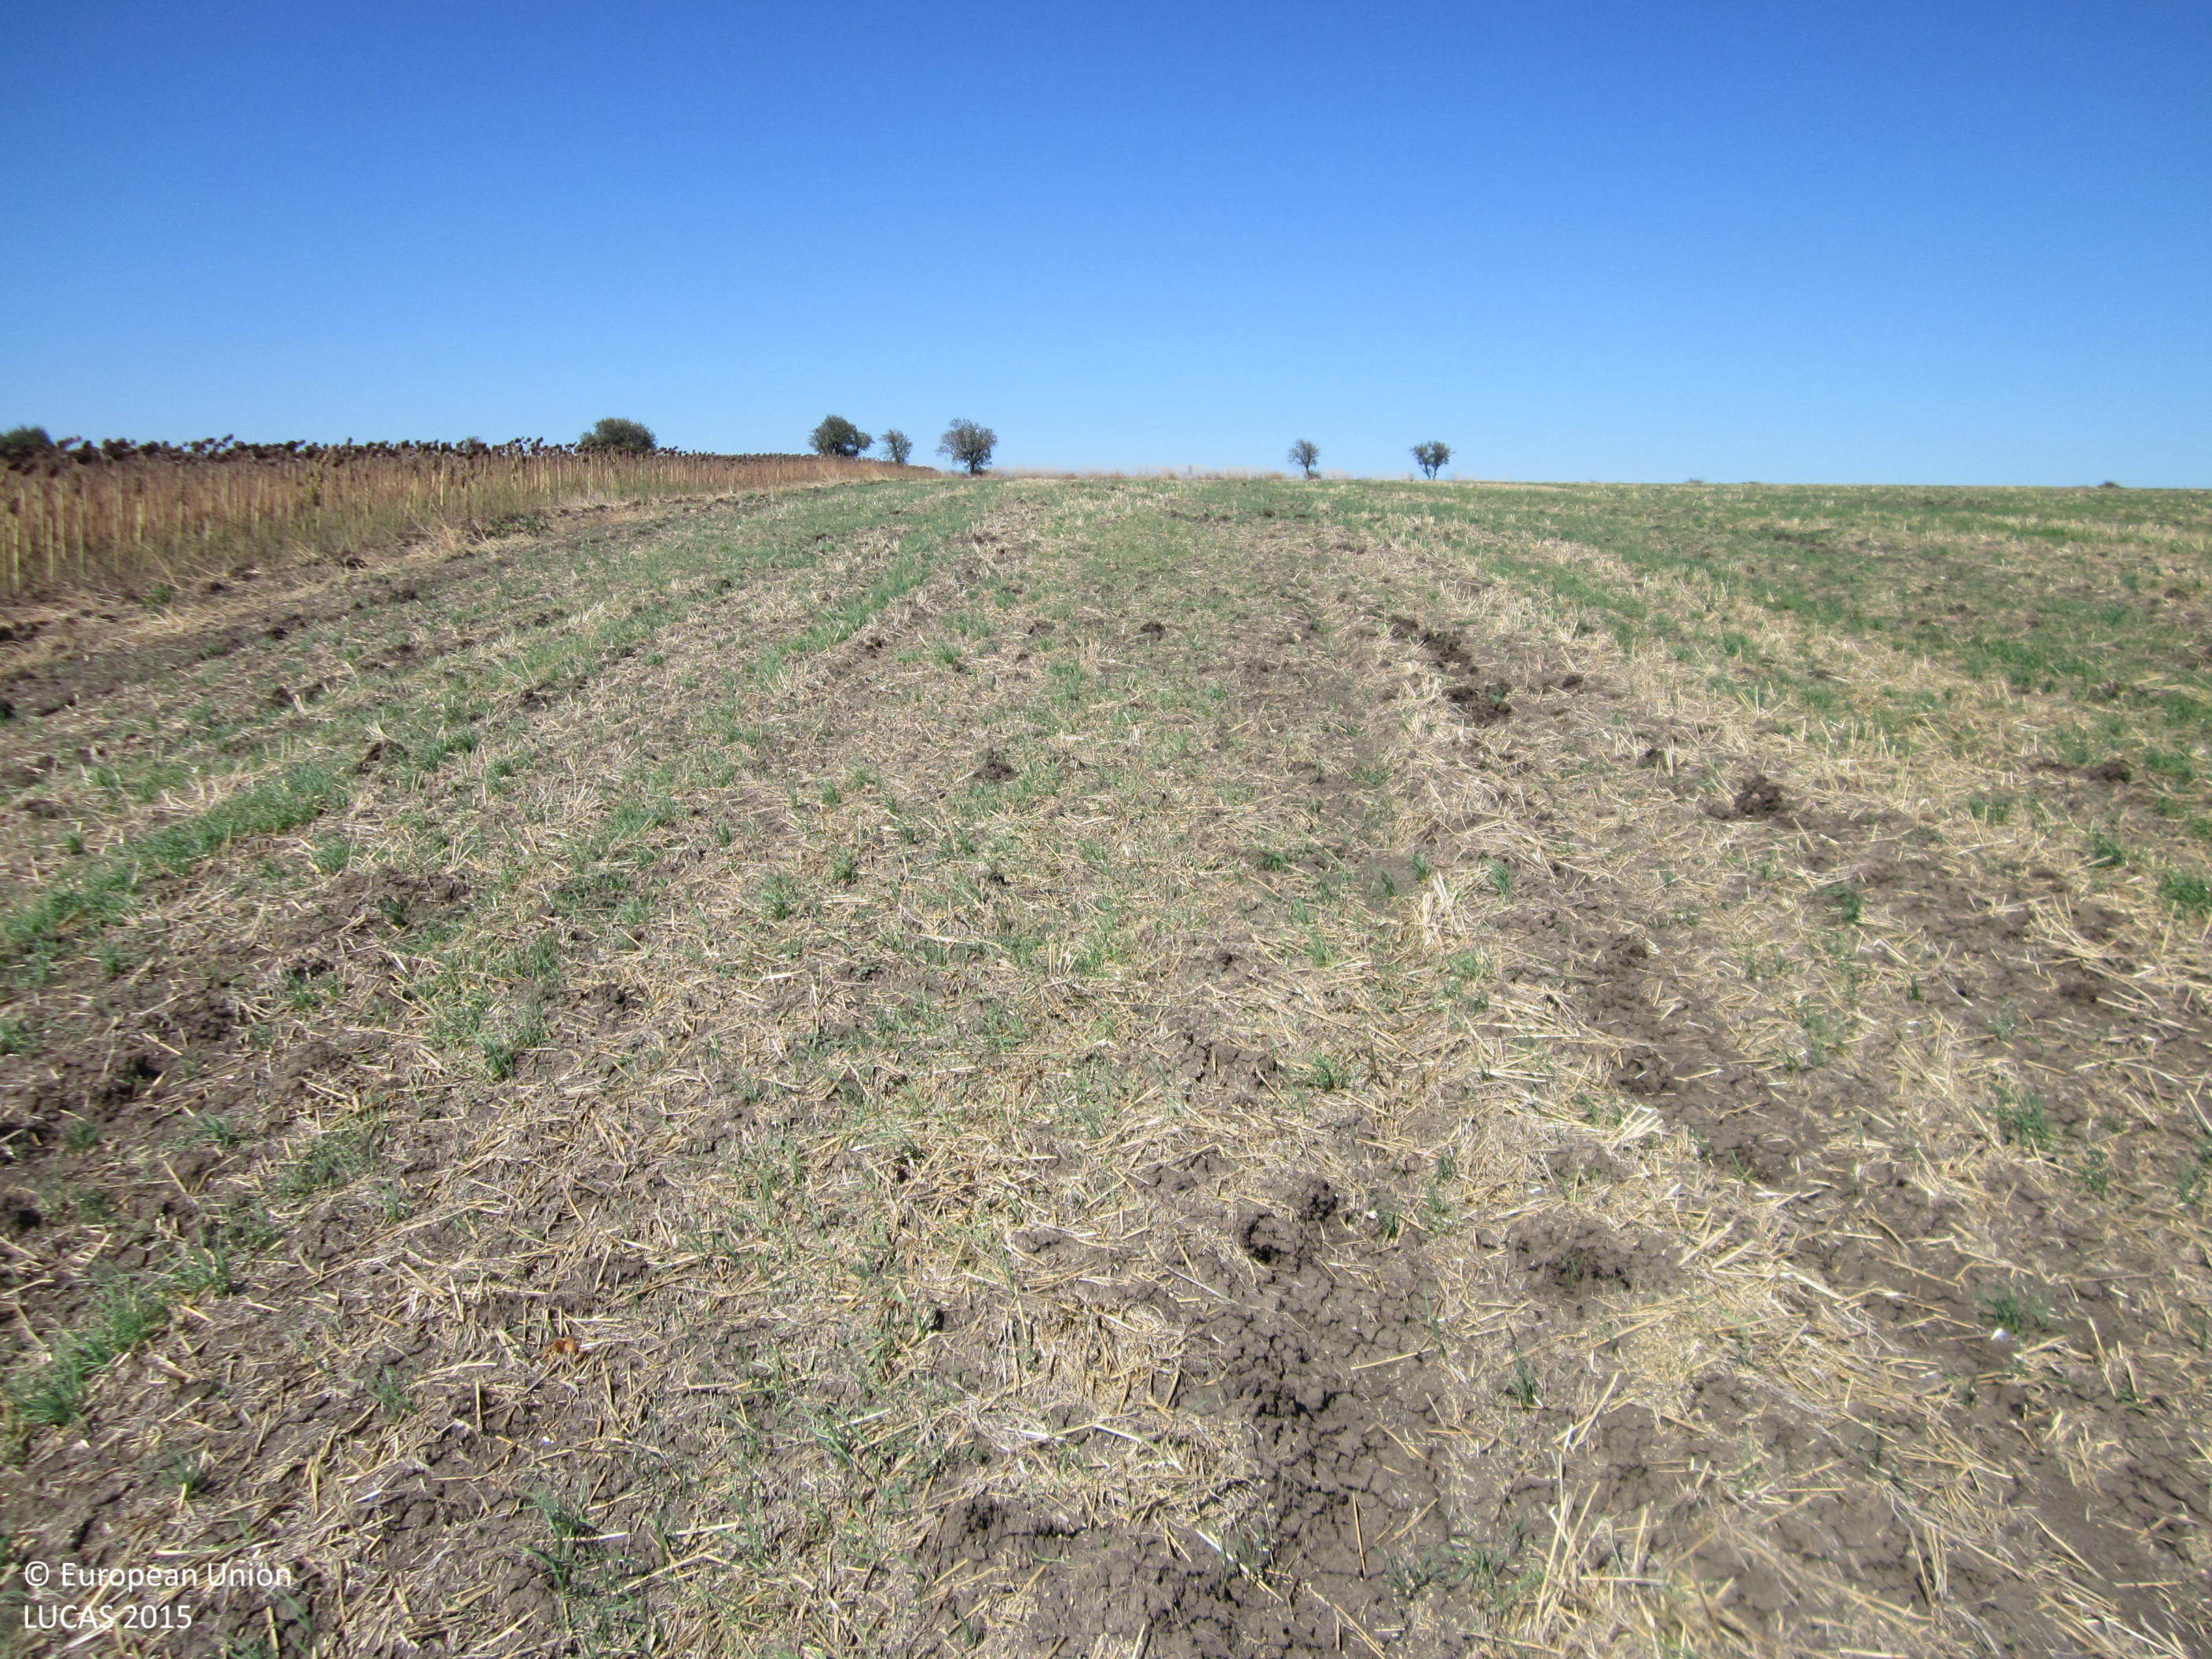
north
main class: Cropland
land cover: Common wheat
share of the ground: 25 - 50 %
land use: Agriculture (excluding fallow land and kitchen gardens)
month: September
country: BG
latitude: 42.4886
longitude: 27.0285
